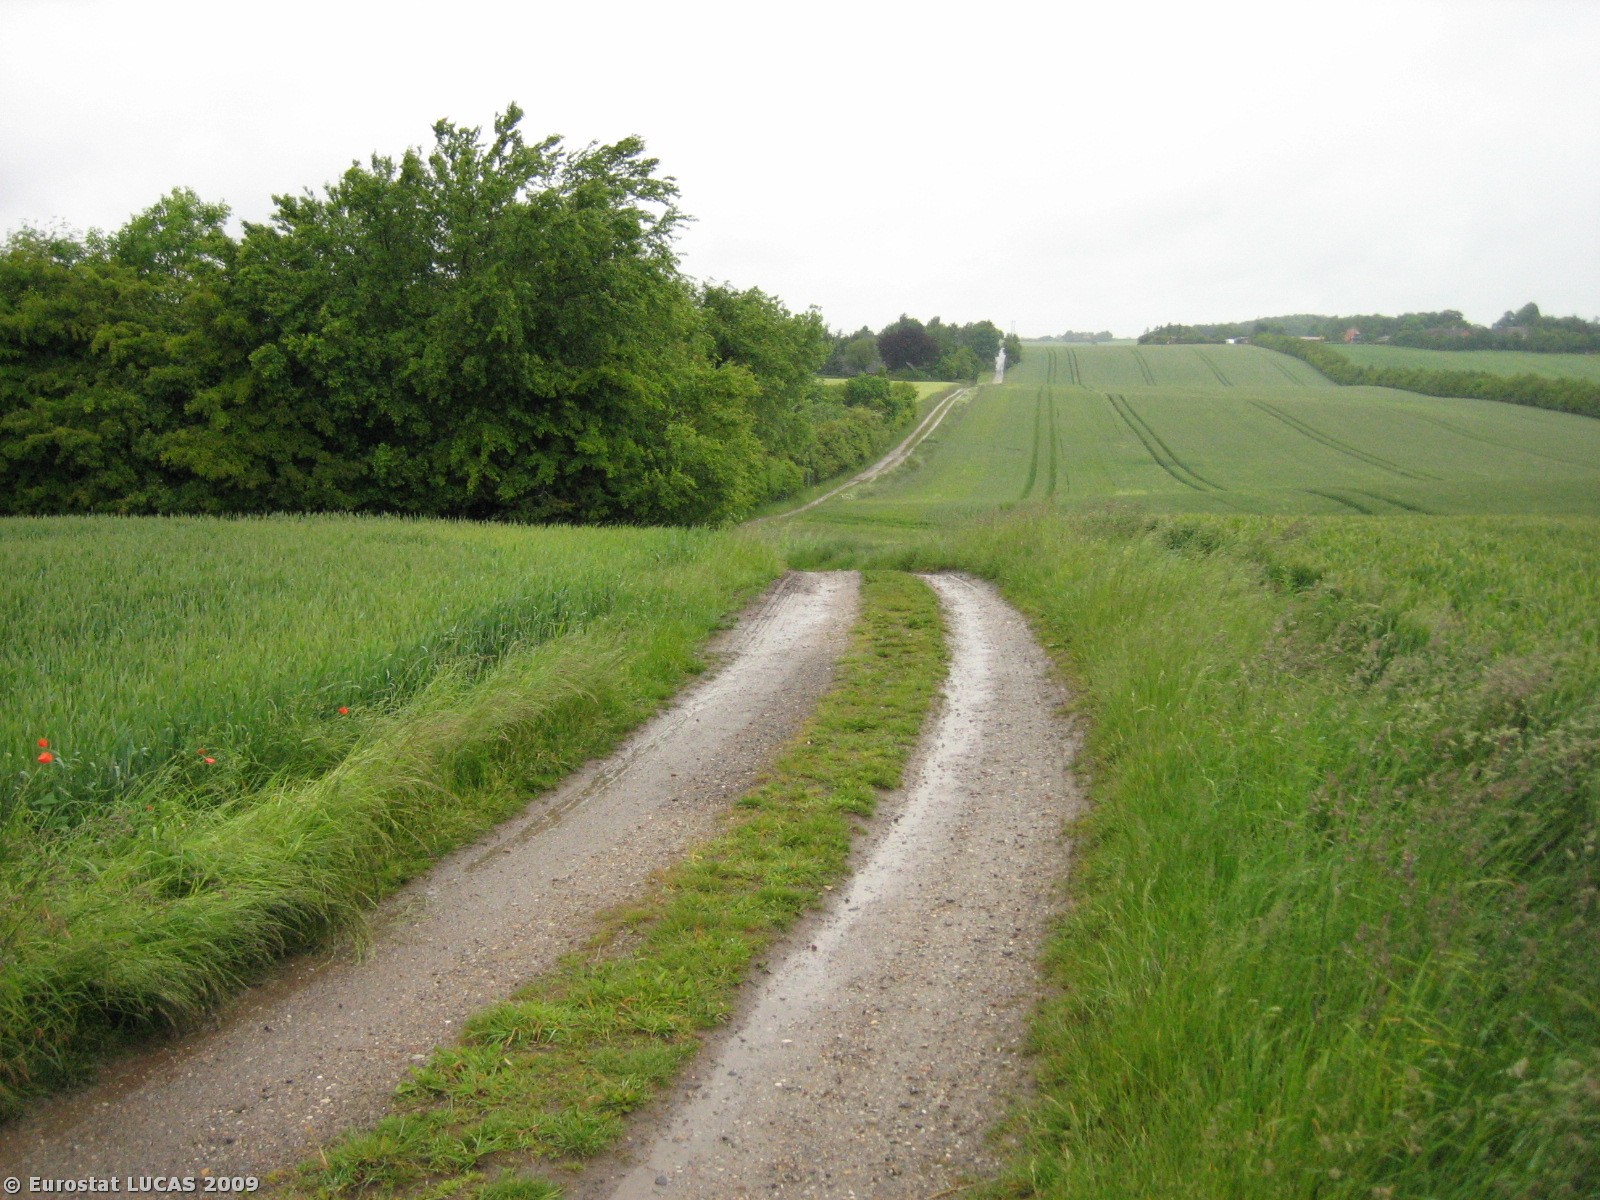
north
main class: Cropland
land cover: Common wheat
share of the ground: > 75 %
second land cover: Barley
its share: < 10 %
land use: Agriculture (excluding fallow land and kitchen gardens)
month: June
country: DK
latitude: 56.0260
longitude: 9.9840
